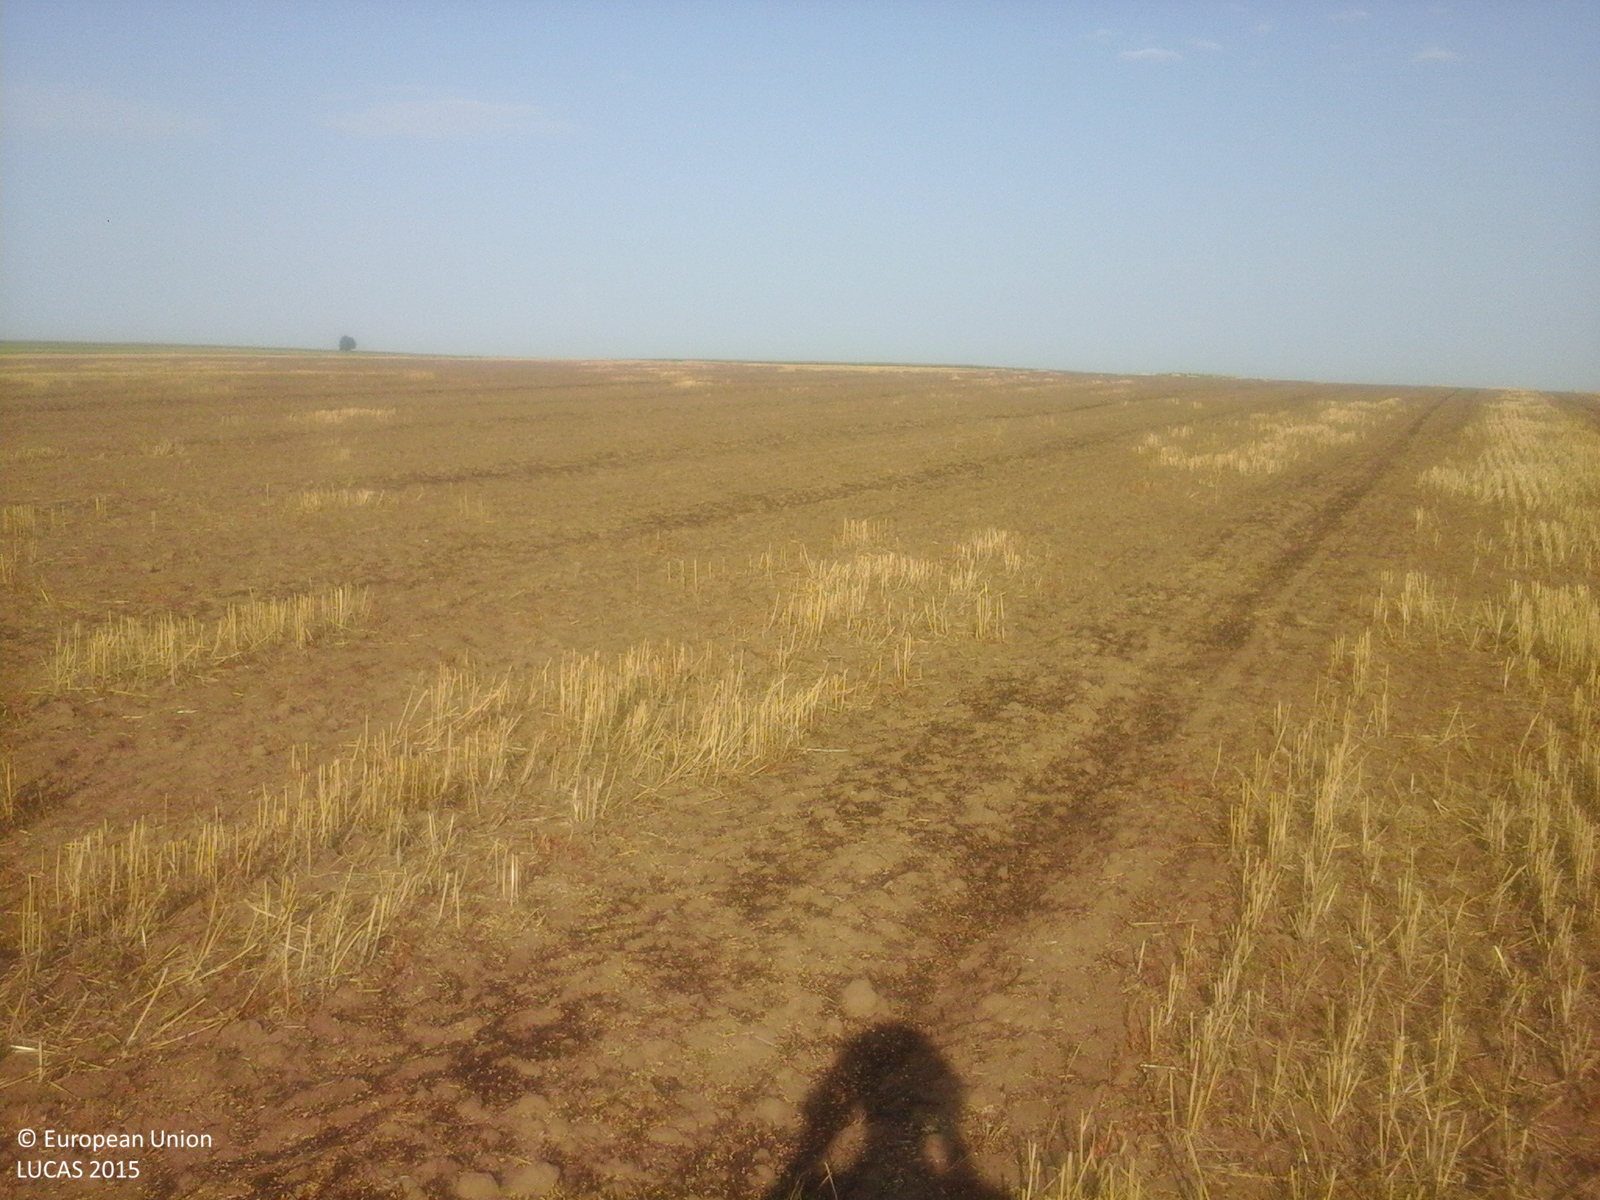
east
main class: Cropland
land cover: Durum wheat
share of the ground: 25 - 50 %
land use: Agriculture (excluding fallow land and kitchen gardens)
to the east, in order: Durum wheat
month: August
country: RO
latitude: 43.9926
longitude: 28.0210
